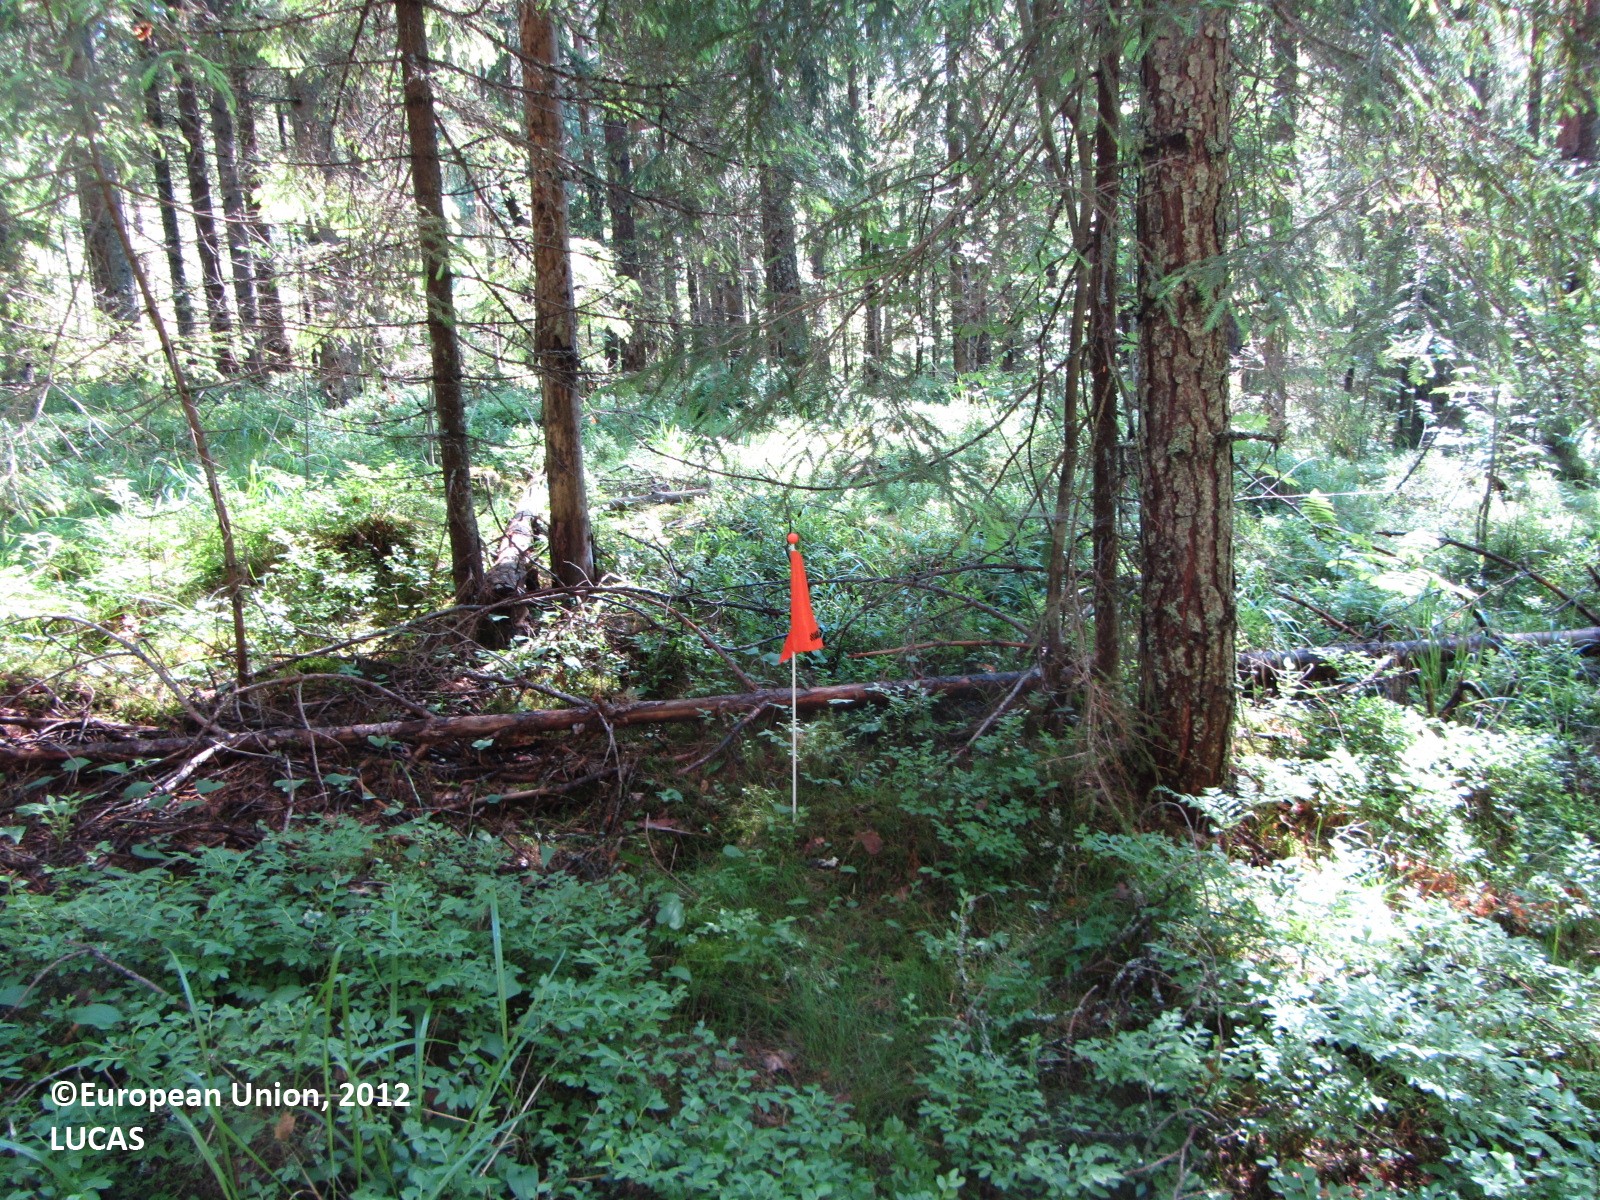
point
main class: Woodland
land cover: Other coniferous woodland
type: boreal forest
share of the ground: 50 - 75 %
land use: Forestry
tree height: > 5 m
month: June
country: FI
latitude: 62.1211
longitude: 25.2735
